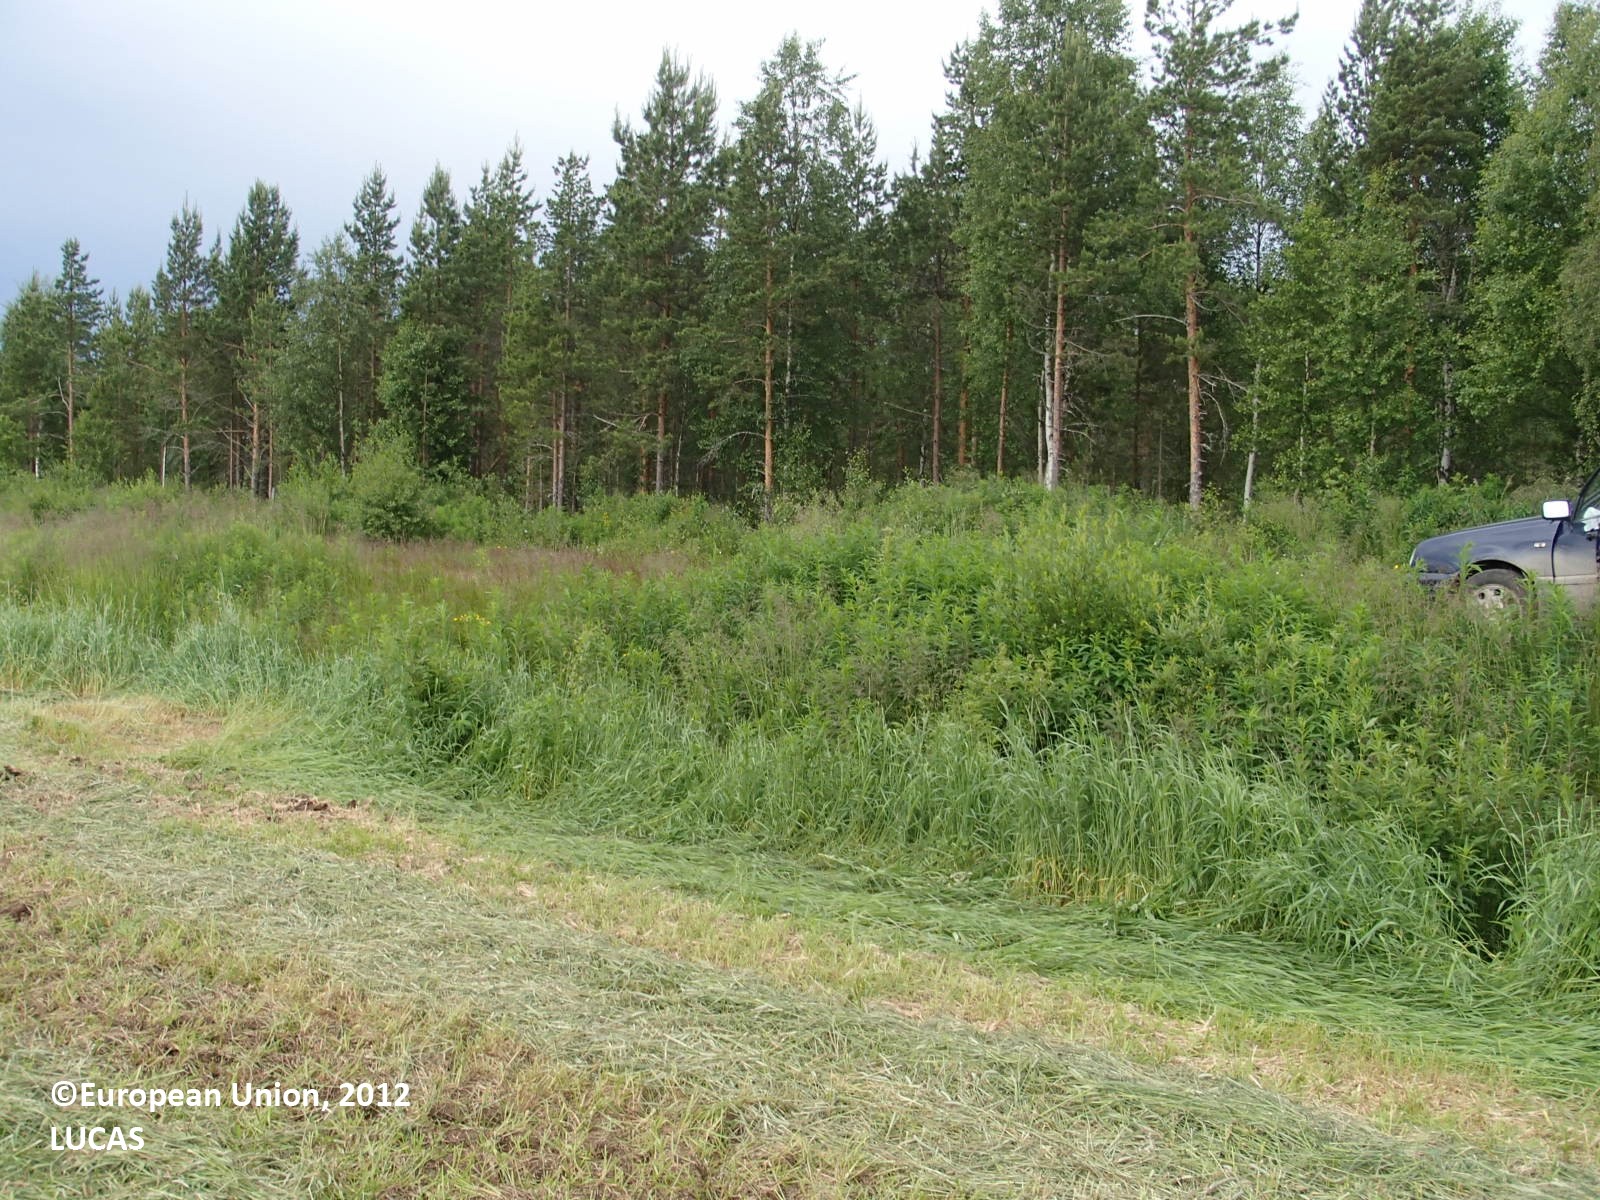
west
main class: Cropland
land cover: Temporary grasslands
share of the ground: > 75 %
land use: Agriculture (excluding fallow land and kitchen gardens)
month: July
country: FI
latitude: 64.1385
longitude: 27.0025
